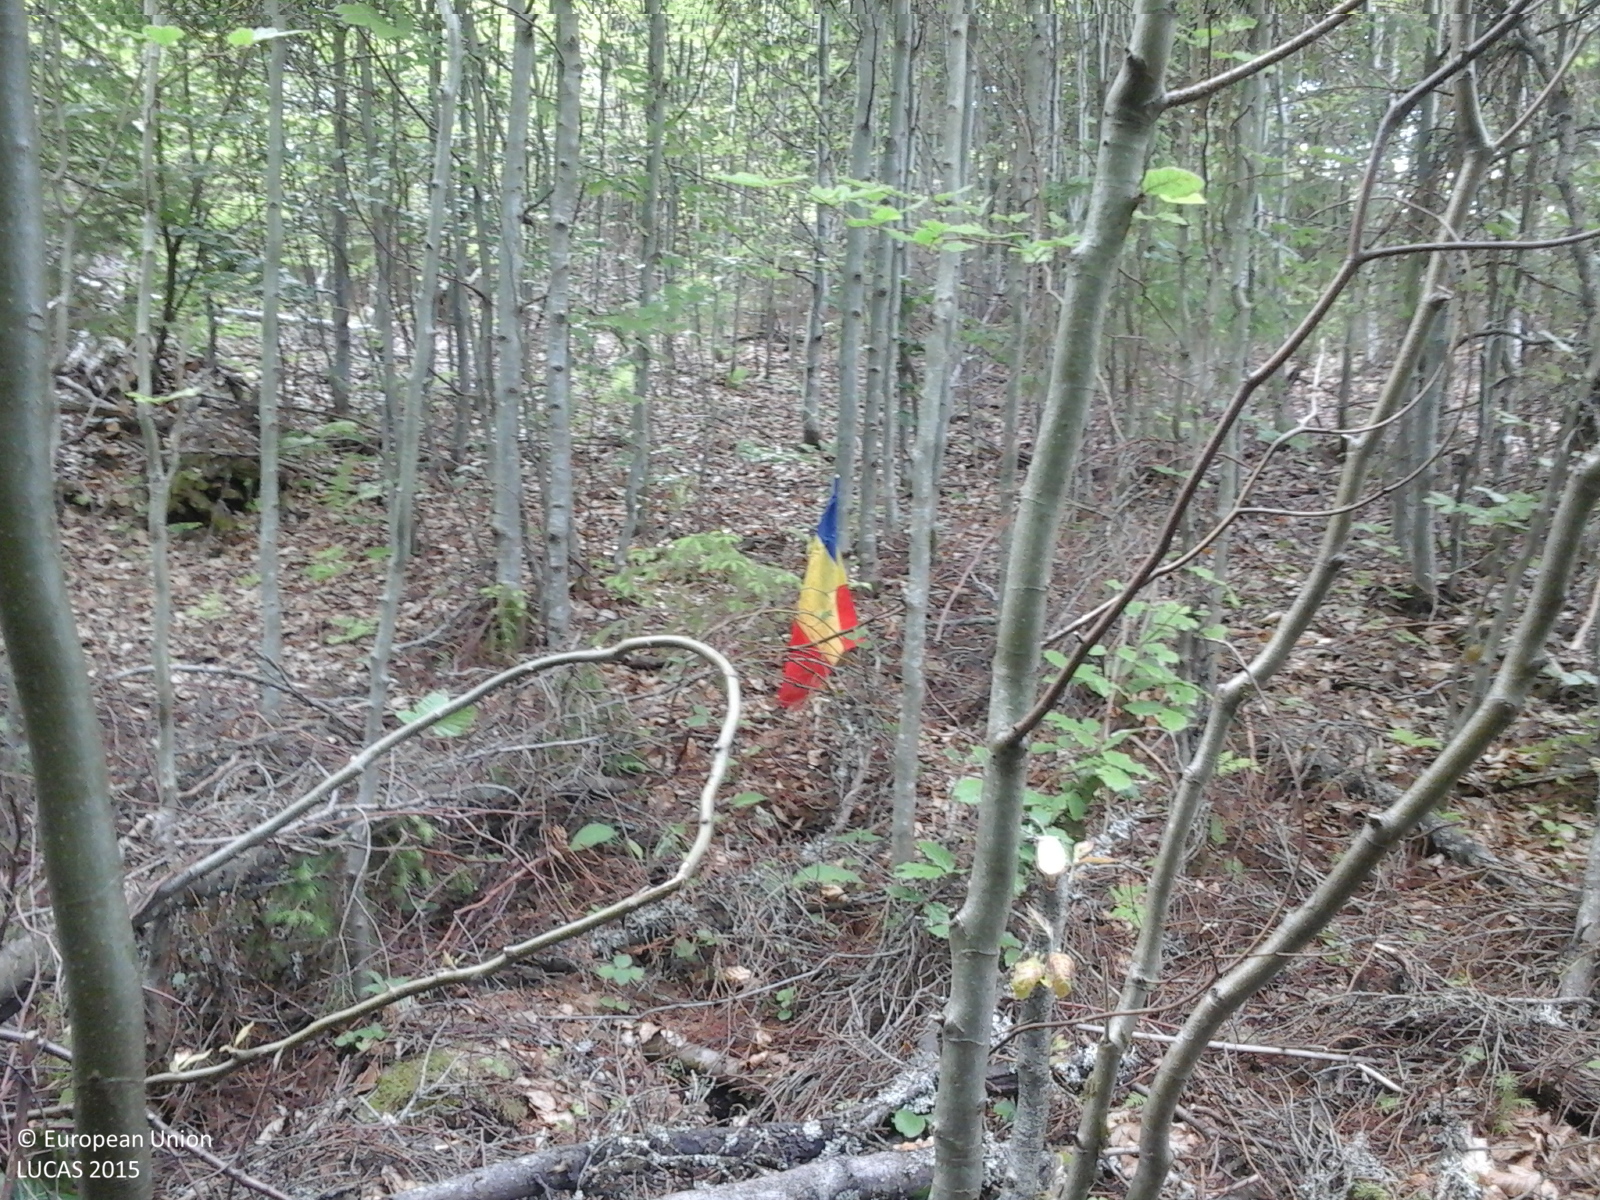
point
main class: Woodland
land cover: Broadleaved woodland
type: beech forest
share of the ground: > 75 %
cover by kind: broadleaved forest trees 100 %
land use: Forestry
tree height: > 5 m
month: June
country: RO
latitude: 47.2912
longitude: 25.0595
